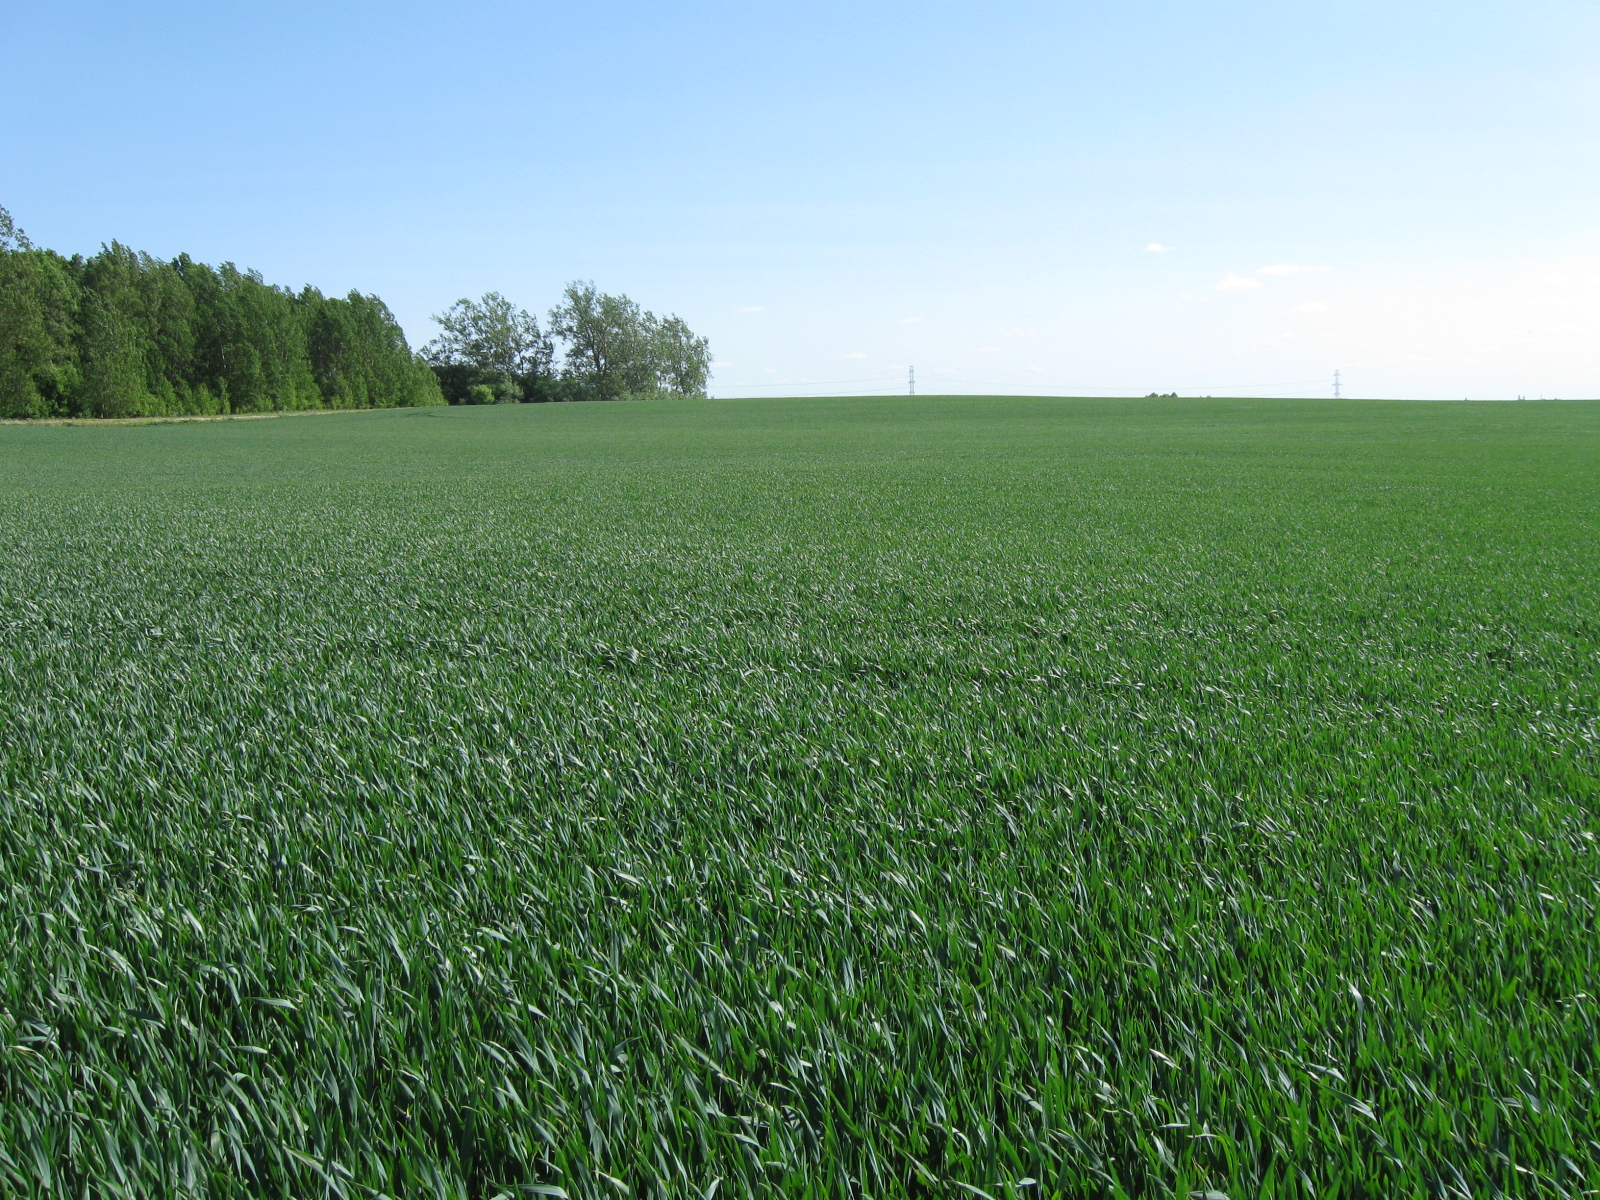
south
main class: Cropland
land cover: Common wheat
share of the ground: > 75 %
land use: Agriculture (excluding fallow land and kitchen gardens)
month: June
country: LT
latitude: 54.4225
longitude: 23.7264
